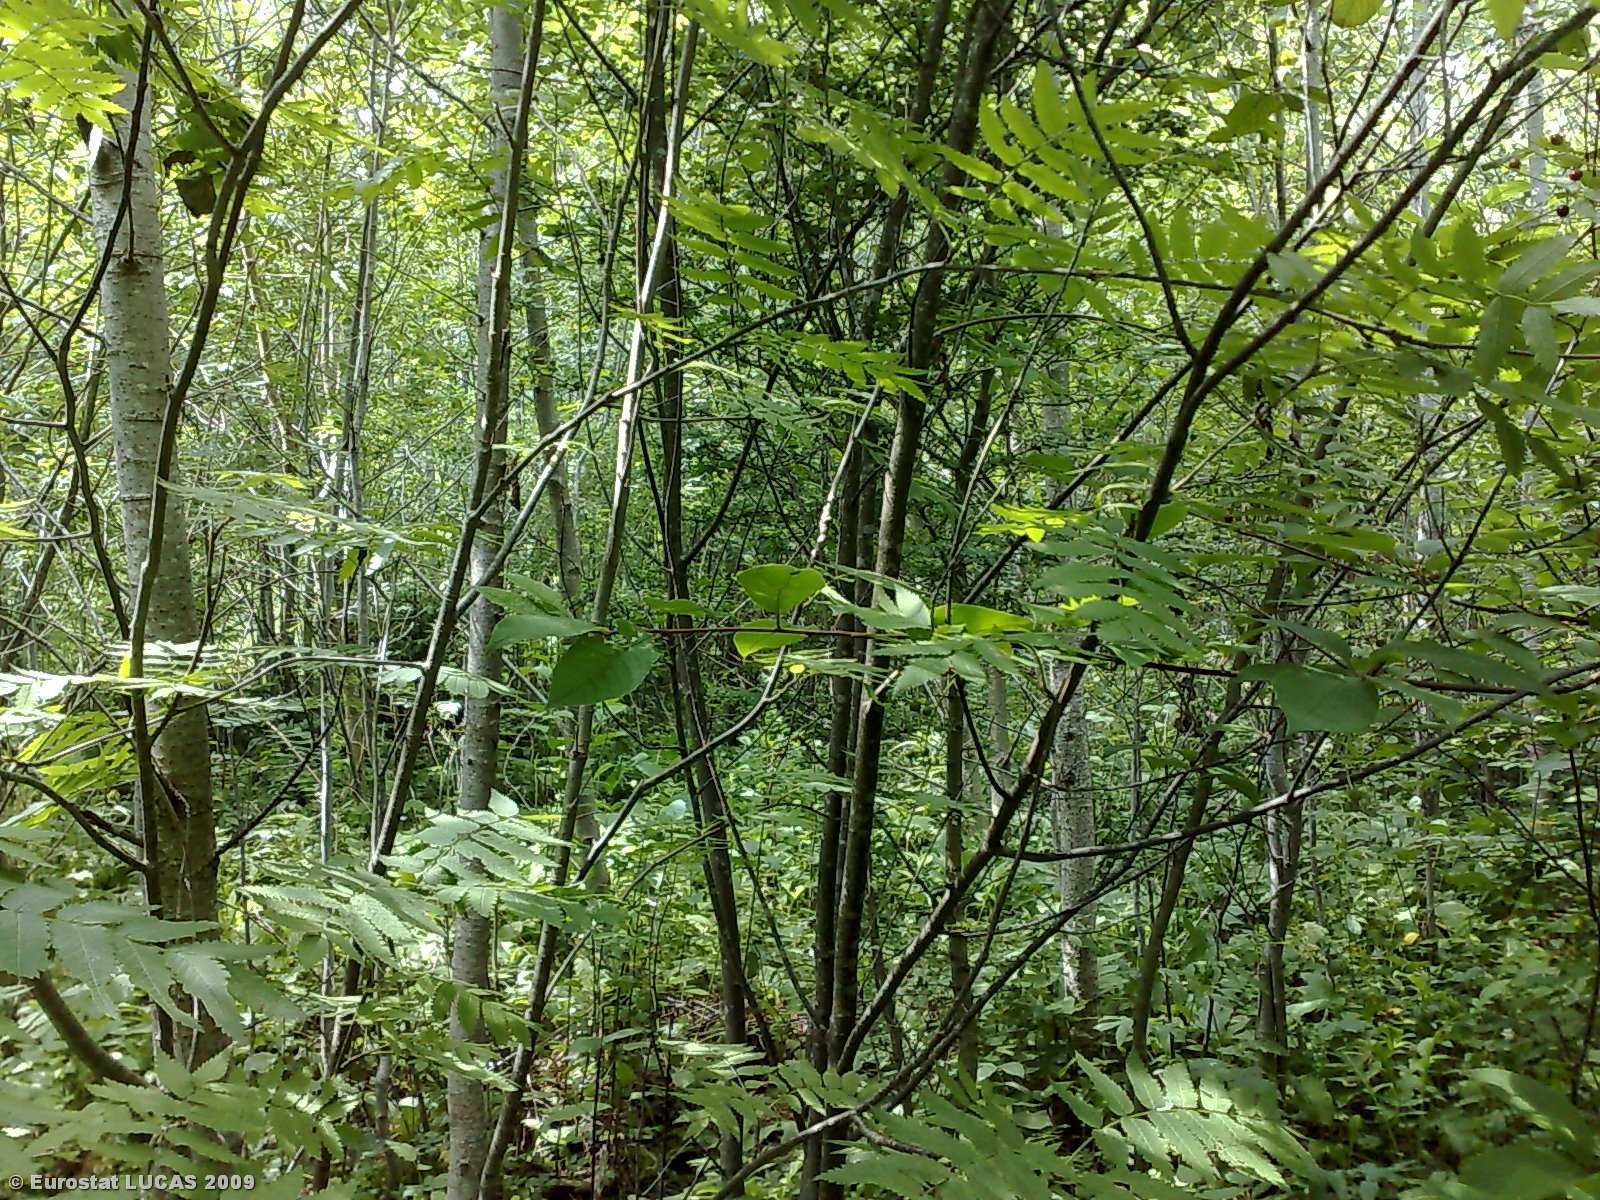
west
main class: Woodland
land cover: Broadleaved woodland
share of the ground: > 75 %
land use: Forestry
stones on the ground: < 10 %
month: July
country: LT
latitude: 55.9883
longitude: 22.9062
